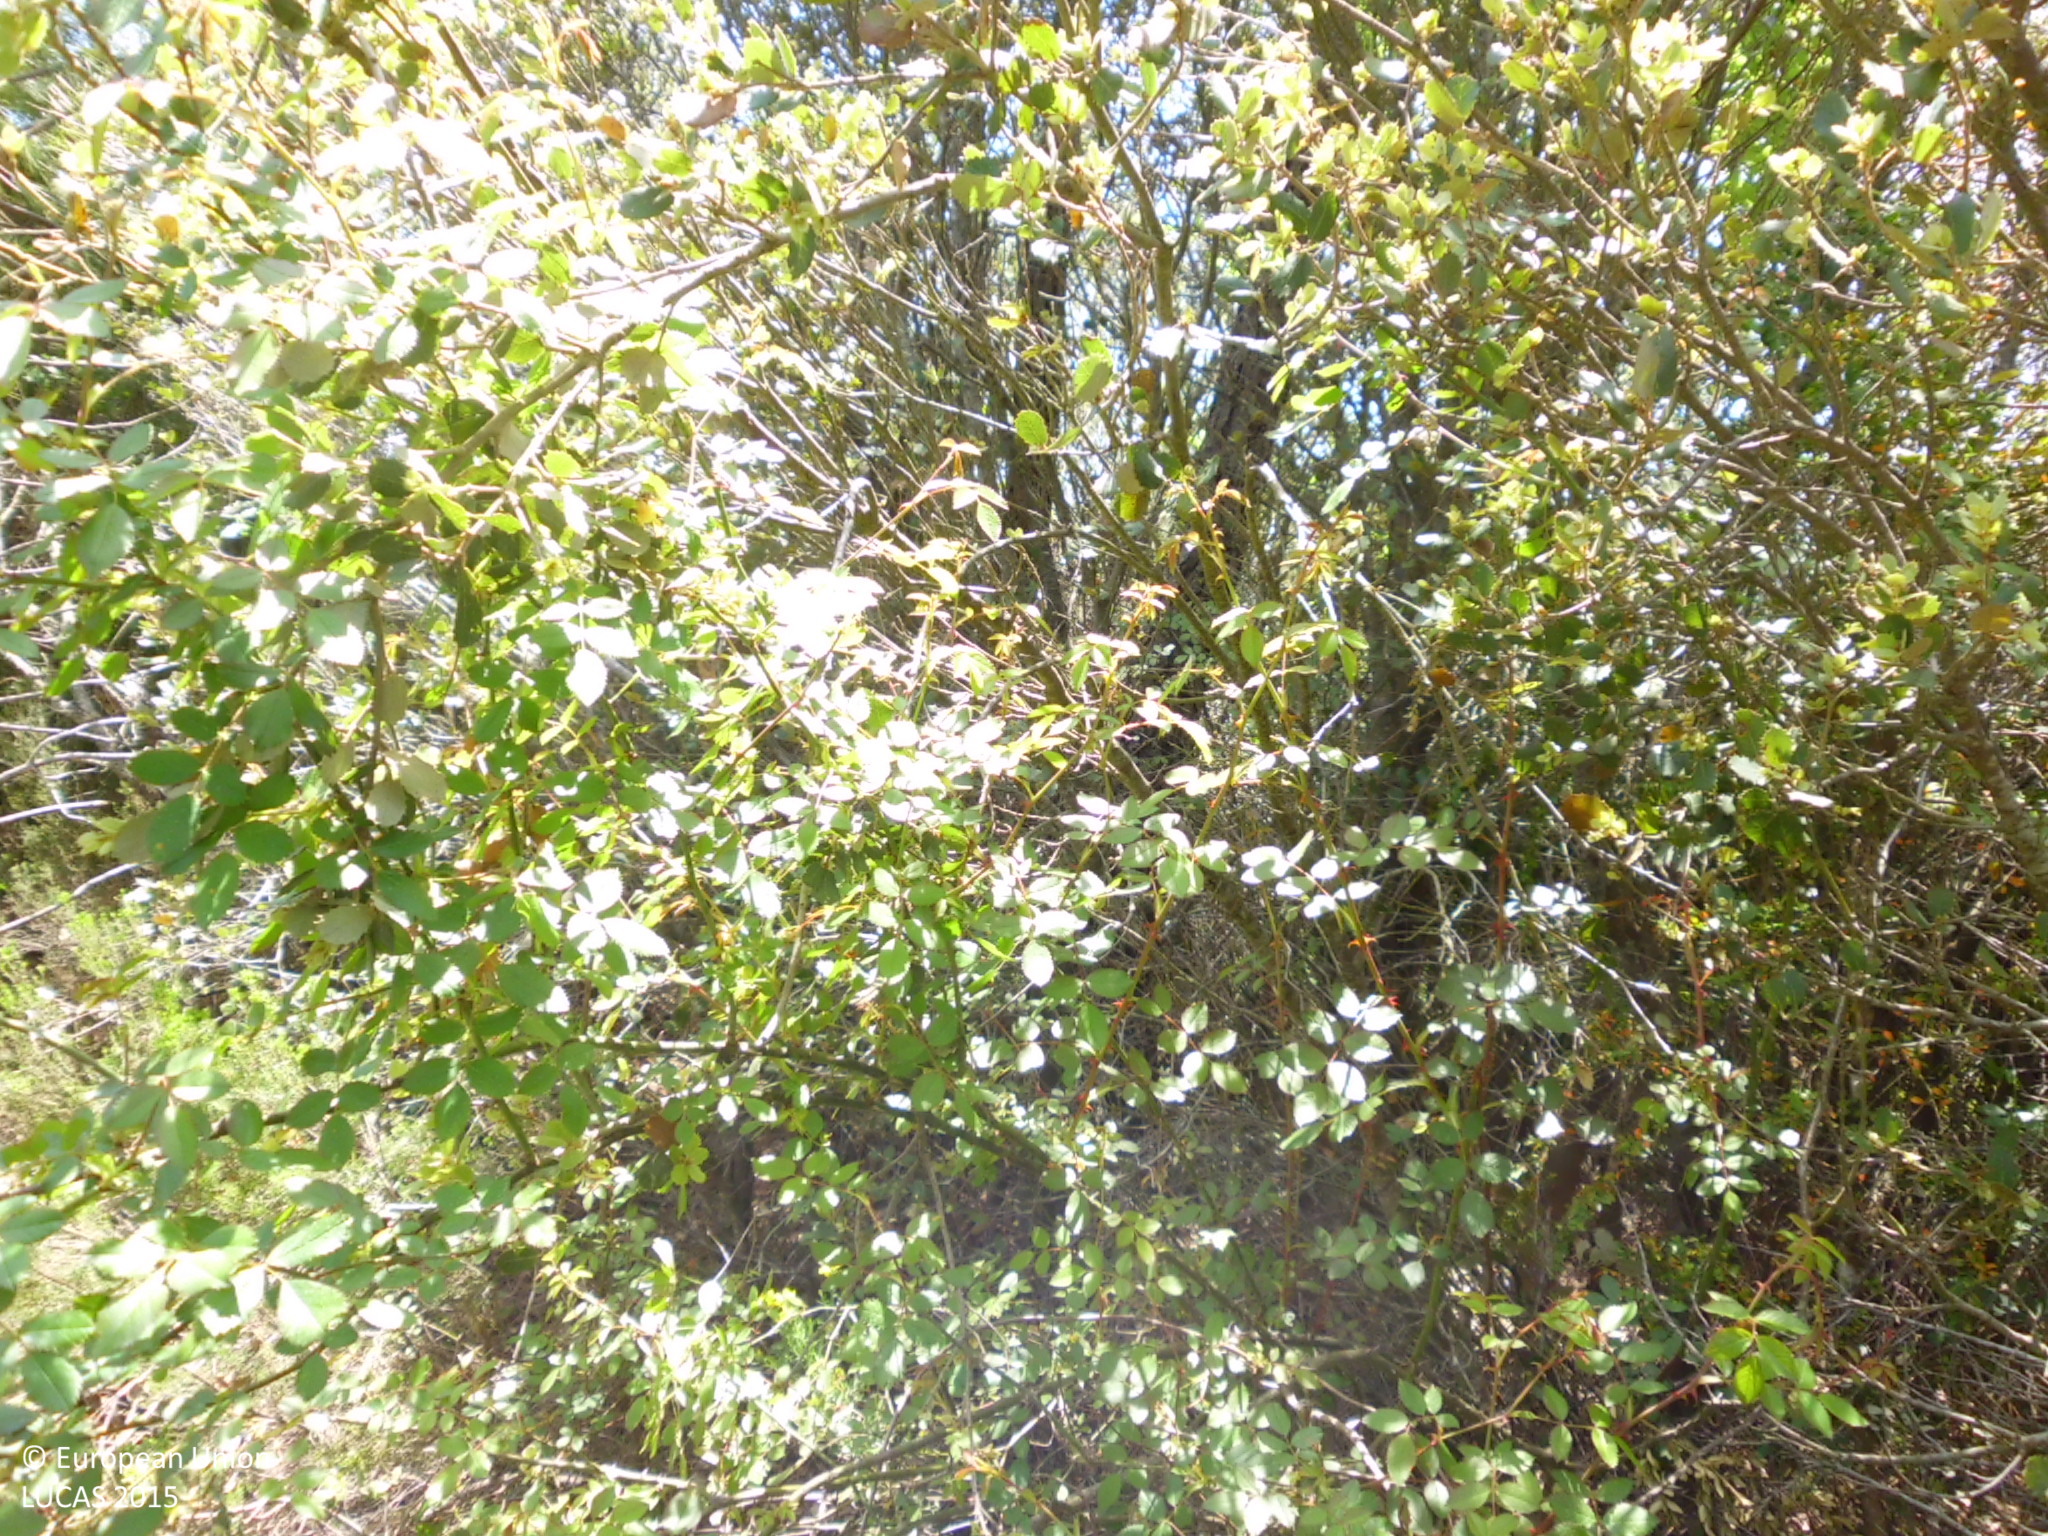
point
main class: Woodland
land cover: Pine dominated coniferous woodland
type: coniferous forest of the mediterranean region
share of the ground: > 75 %
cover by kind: coniferous forest trees 65 %, broadleaved forest trees 15 %, shrubs 10 %, herbaceous plants 10 %
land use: Semi-natural and natural areas not in use
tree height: > 5 m
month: May
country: ES
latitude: 42.7558
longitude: -3.4650
